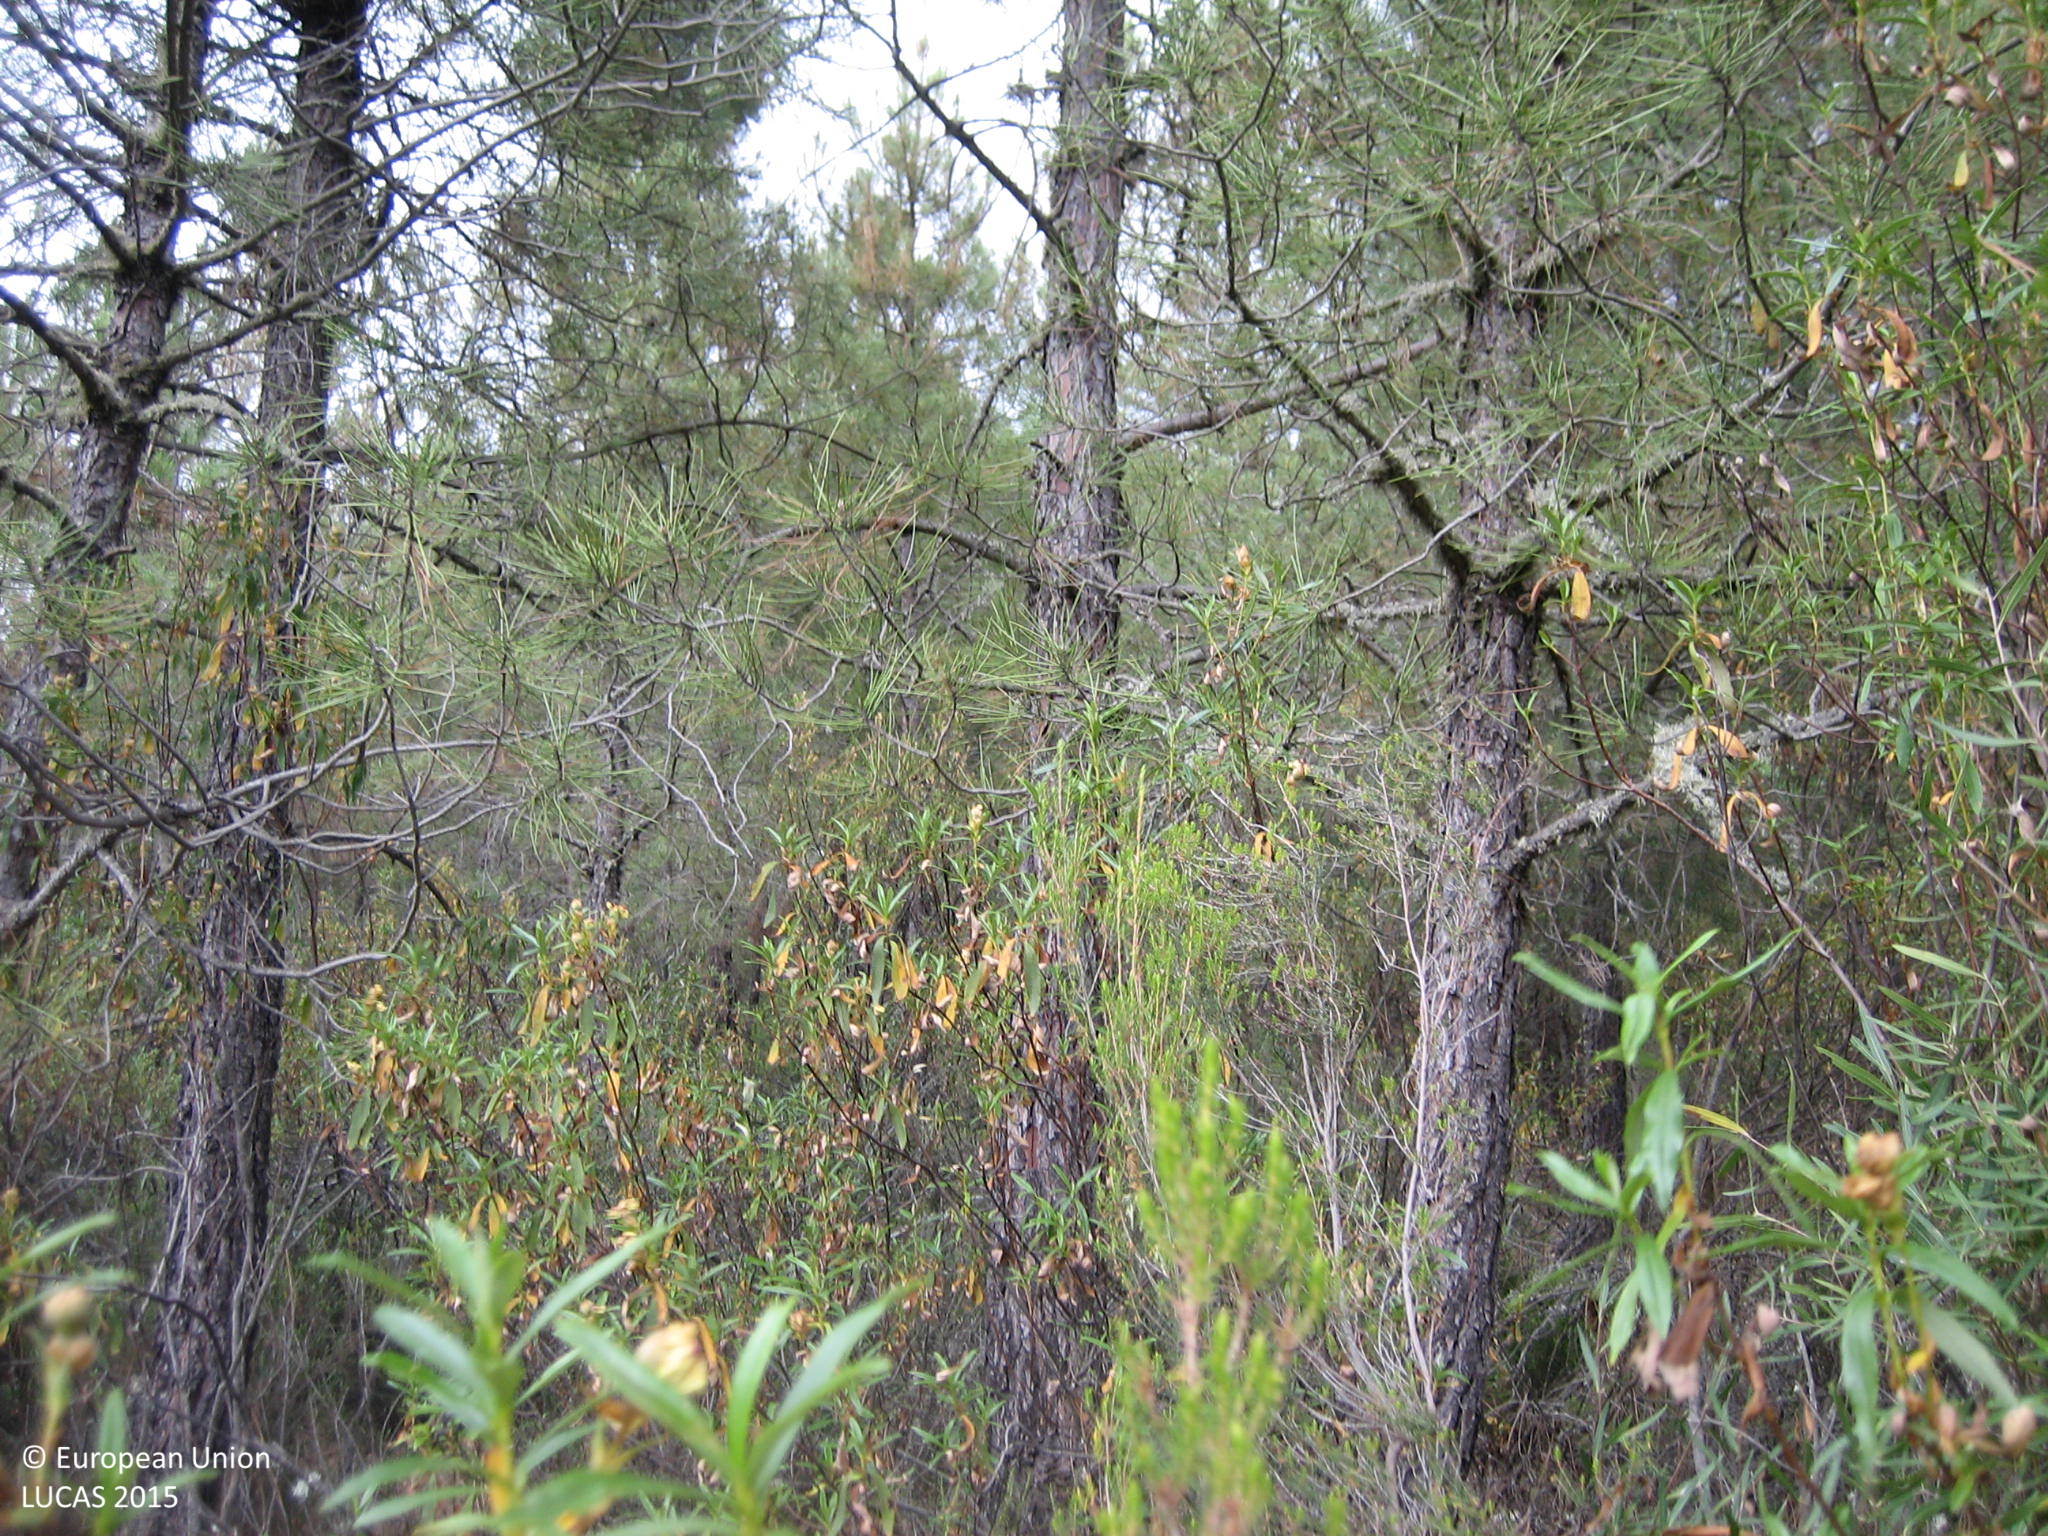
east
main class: Shrubland
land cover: Shrubland with sparse tree cover
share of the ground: > 75 %
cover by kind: shrubs 95 %, broadleaved forest trees 5 %
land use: Semi-natural and natural areas not in use
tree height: < 5 m
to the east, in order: Shrubland with sparse tree cover; Broadleaved woodland; Rivers and streams; Broadleaved woodland; Shrubland with sparse tree cover; Pine dominated coniferous woodland
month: June
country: ES
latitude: 39.0575
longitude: -4.4856
